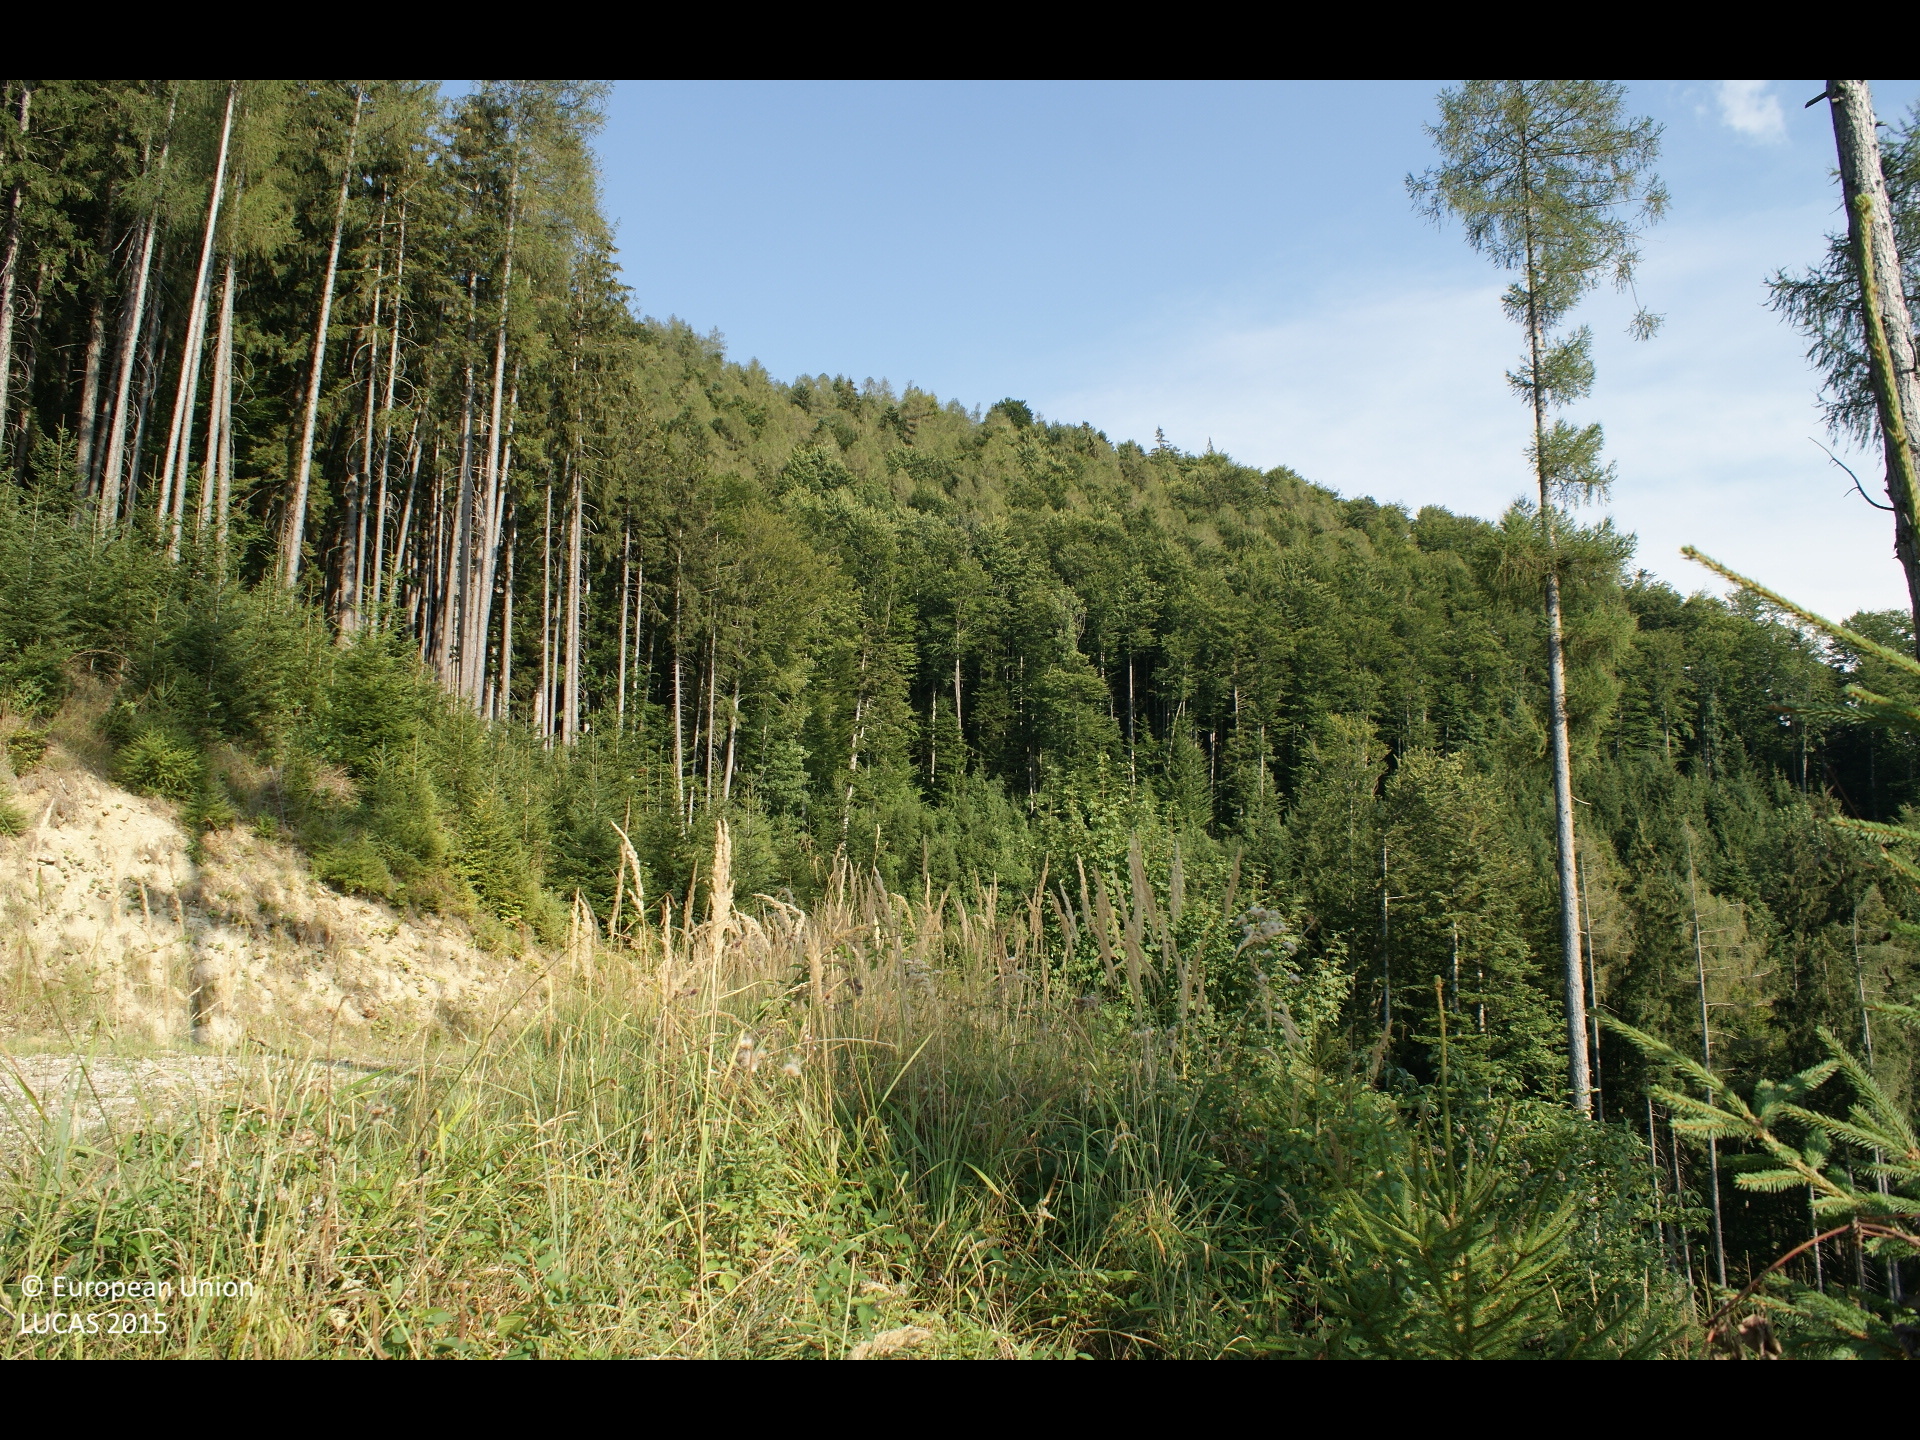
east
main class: Woodland
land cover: Spruce dominated mixed woodland
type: alpine coniferous forest
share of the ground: > 75 %
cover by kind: coniferous forest trees 65 %, broadleaved forest trees 25 %, shrubs 10 %
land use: Forestry
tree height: < 5 m
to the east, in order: Spruce dominated mixed woodland; Tracks; Spruce dominated mixed woodland; Rivers and streams; Other mixed woodland; Tracks; Spruce dominated mixed woodland
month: August
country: AT
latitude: 47.9168
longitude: 14.0003
